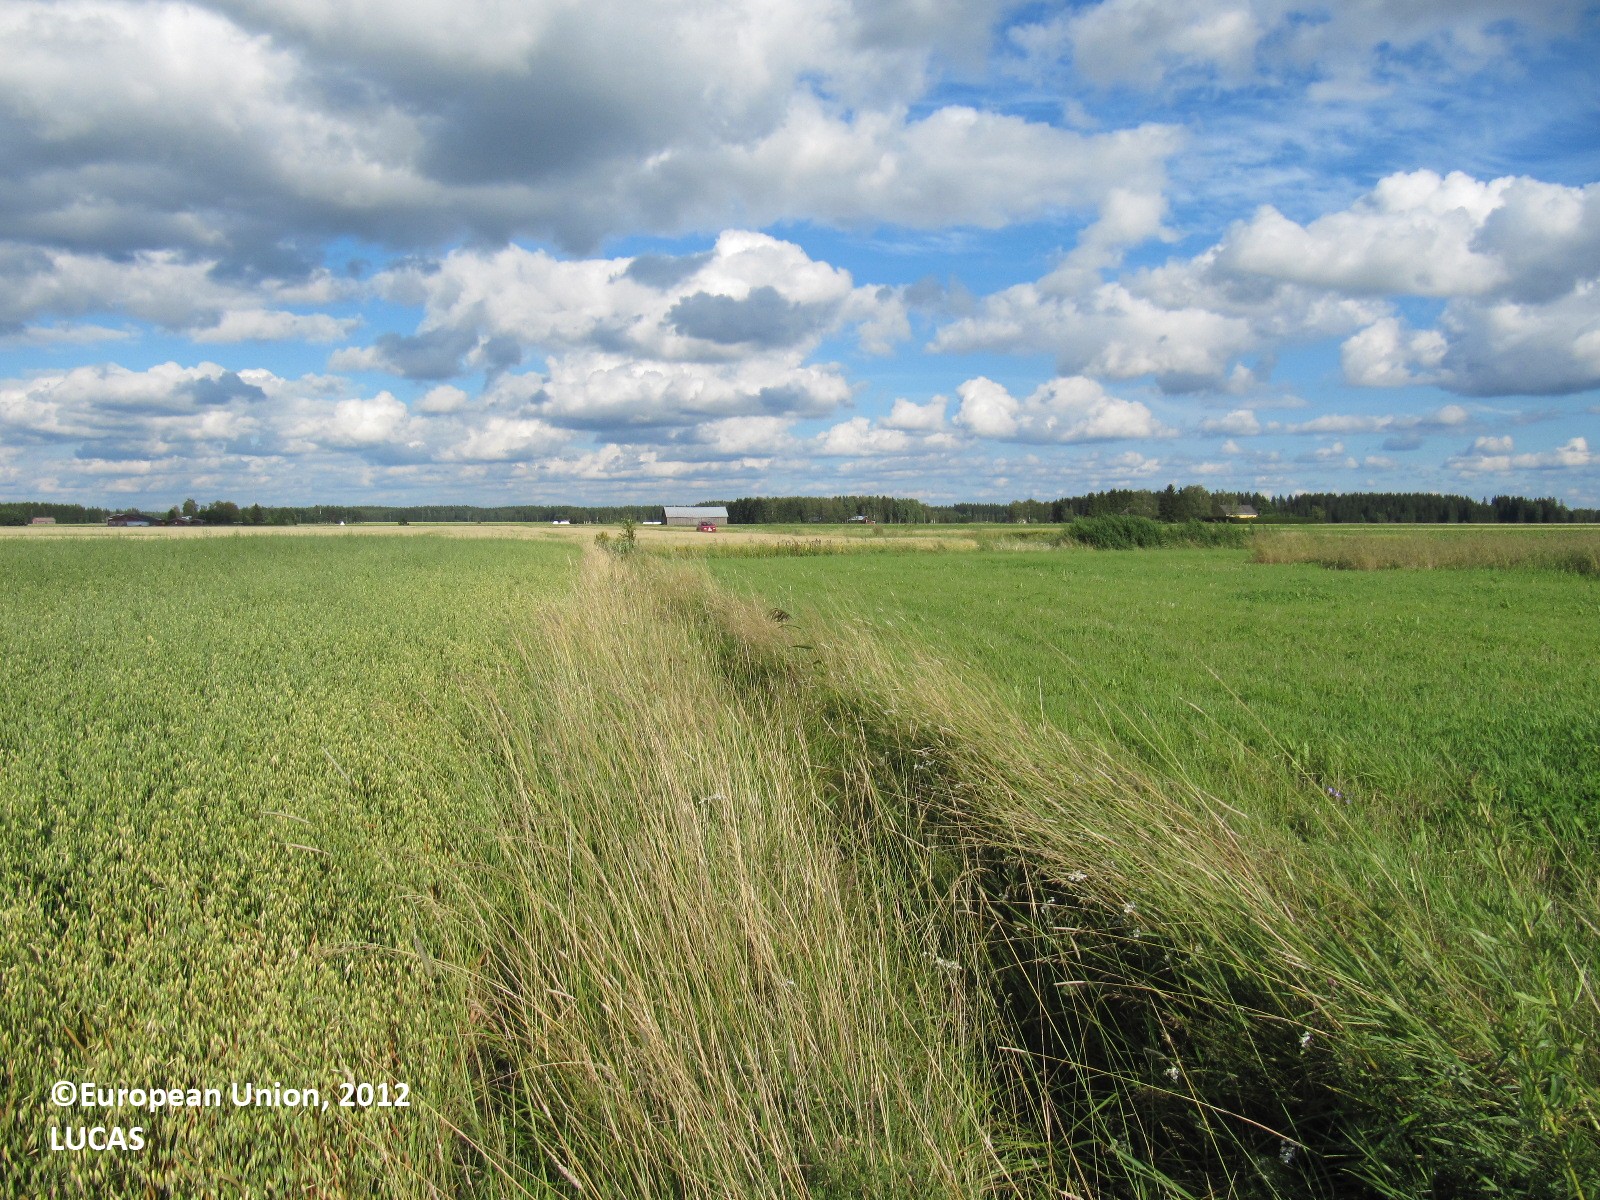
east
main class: Cropland
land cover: Oats
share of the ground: > 75 %
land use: Agriculture (excluding fallow land and kitchen gardens)
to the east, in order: Oats; Ditches and canals; Barley
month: August
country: FI
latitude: 60.5036
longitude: 23.2463
